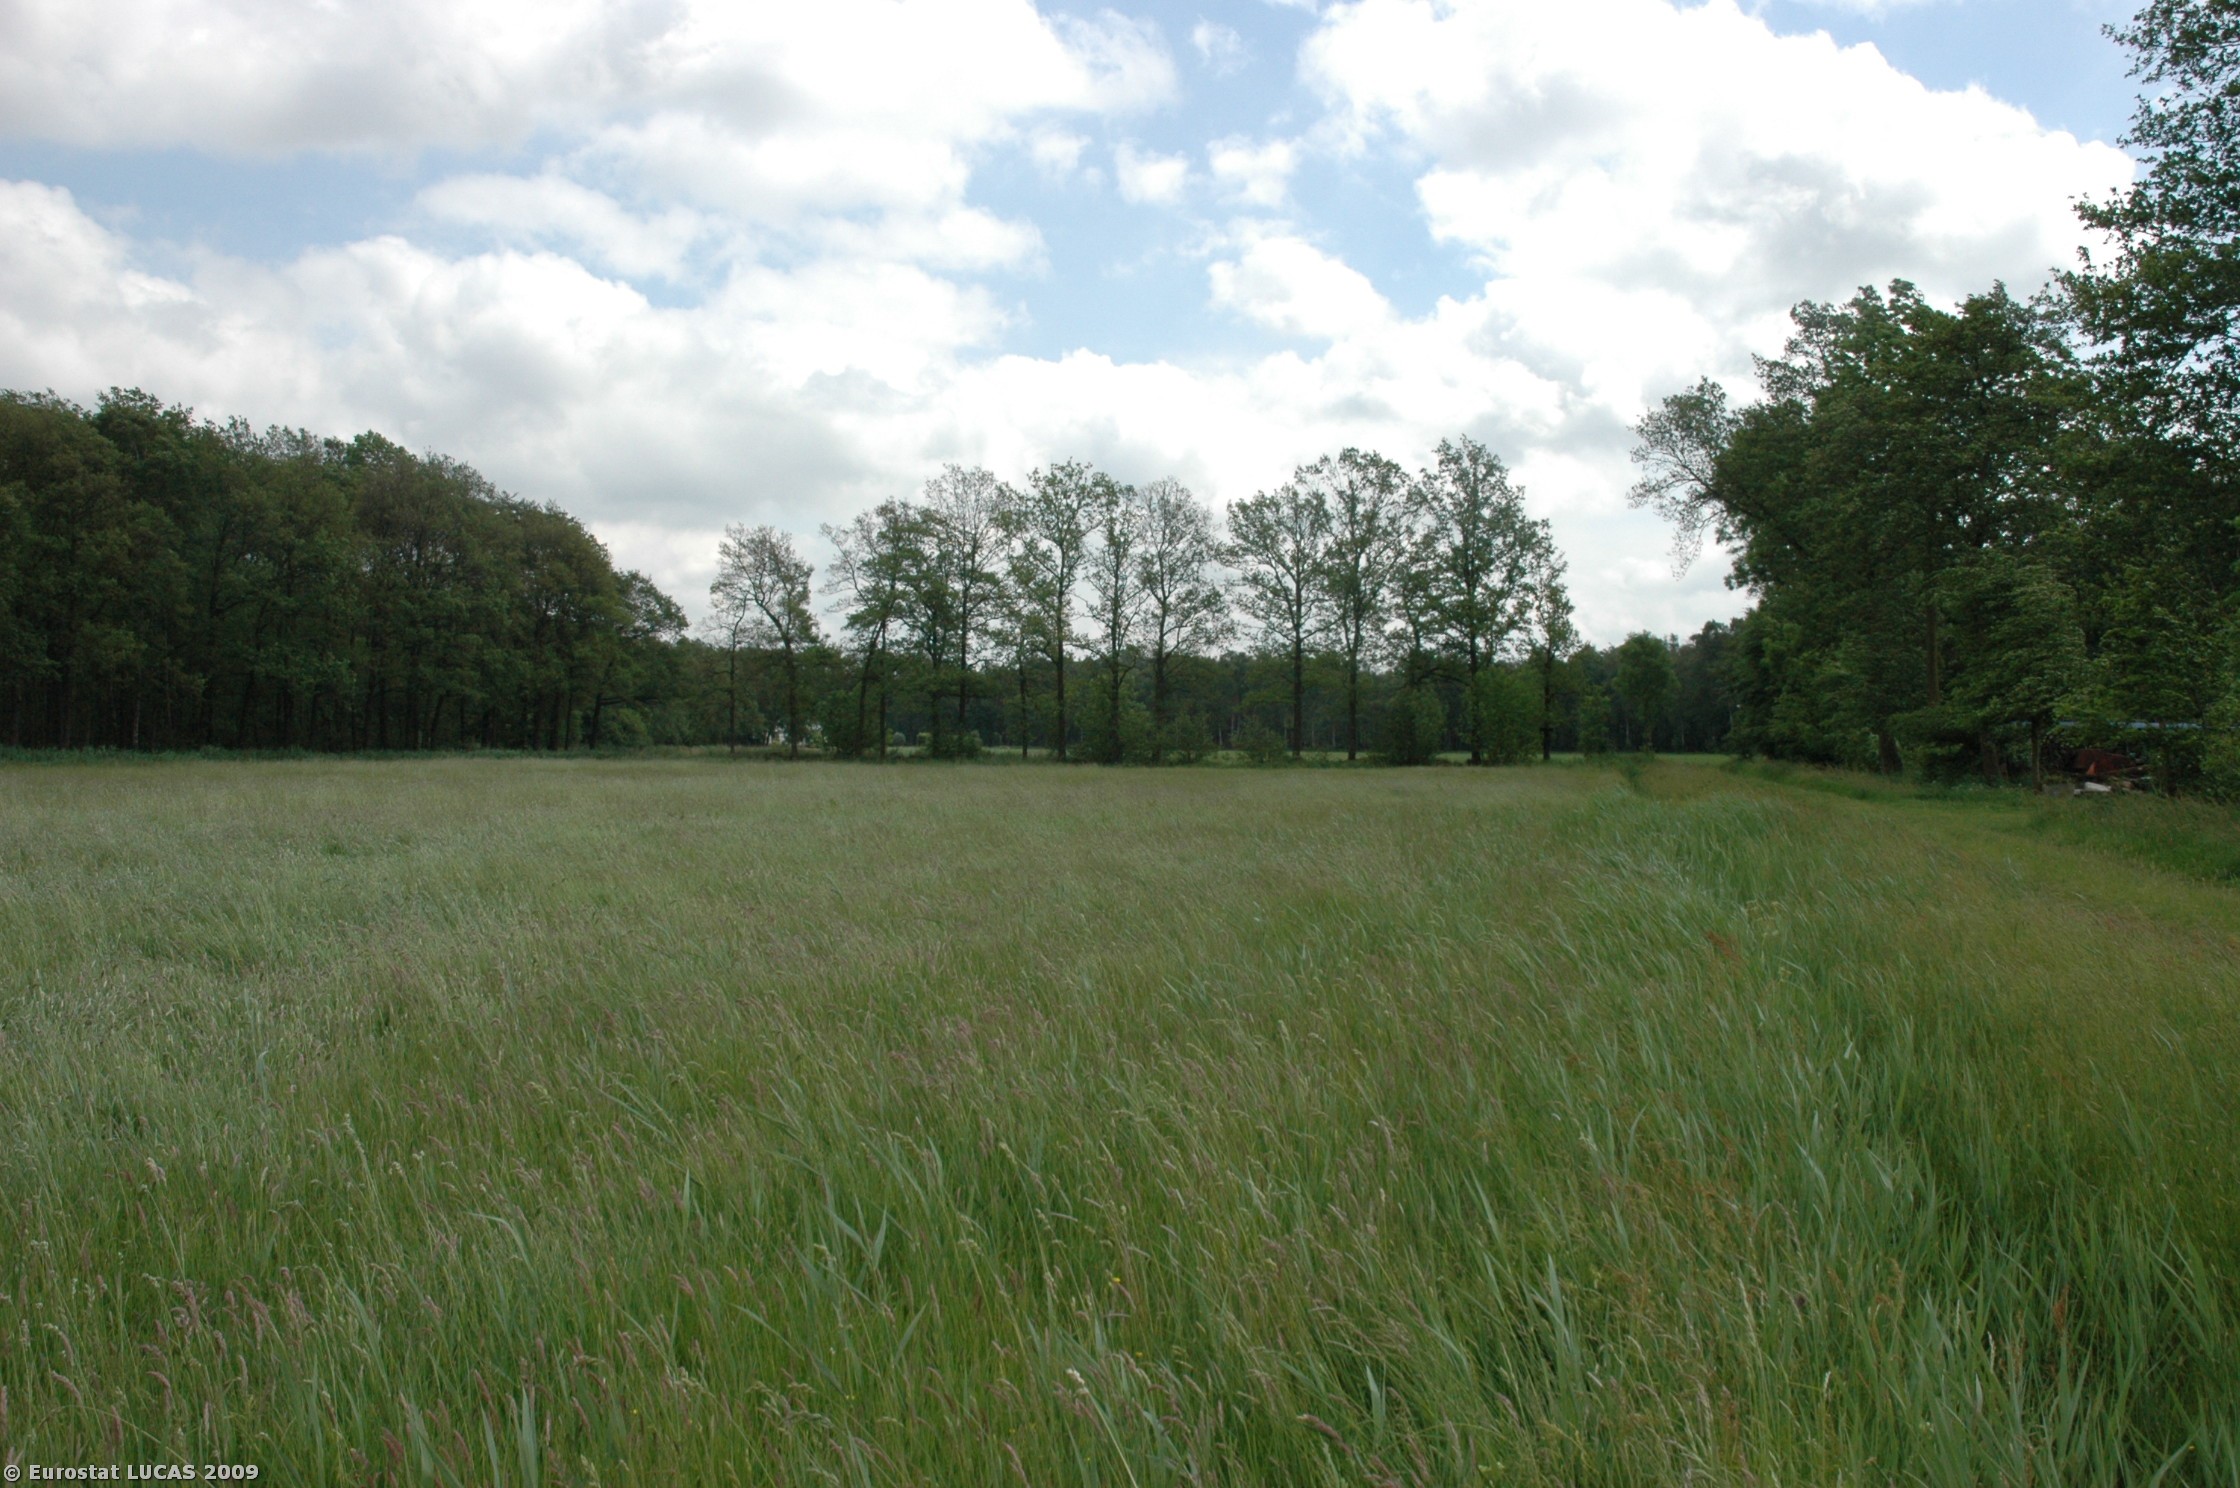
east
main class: Grassland
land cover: Grassland without tree/shrub cover
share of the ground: > 75 %
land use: Agriculture (excluding fallow land and kitchen gardens)
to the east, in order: Grassland without tree/shrub cover; Ditches and canals; Broadleaved woodland; Ditches and canals; Grassland without tree/shrub cover; Ditches and canals; Grassland without tree/shrub cover
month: May
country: NL
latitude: 52.0796
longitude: 6.1032
